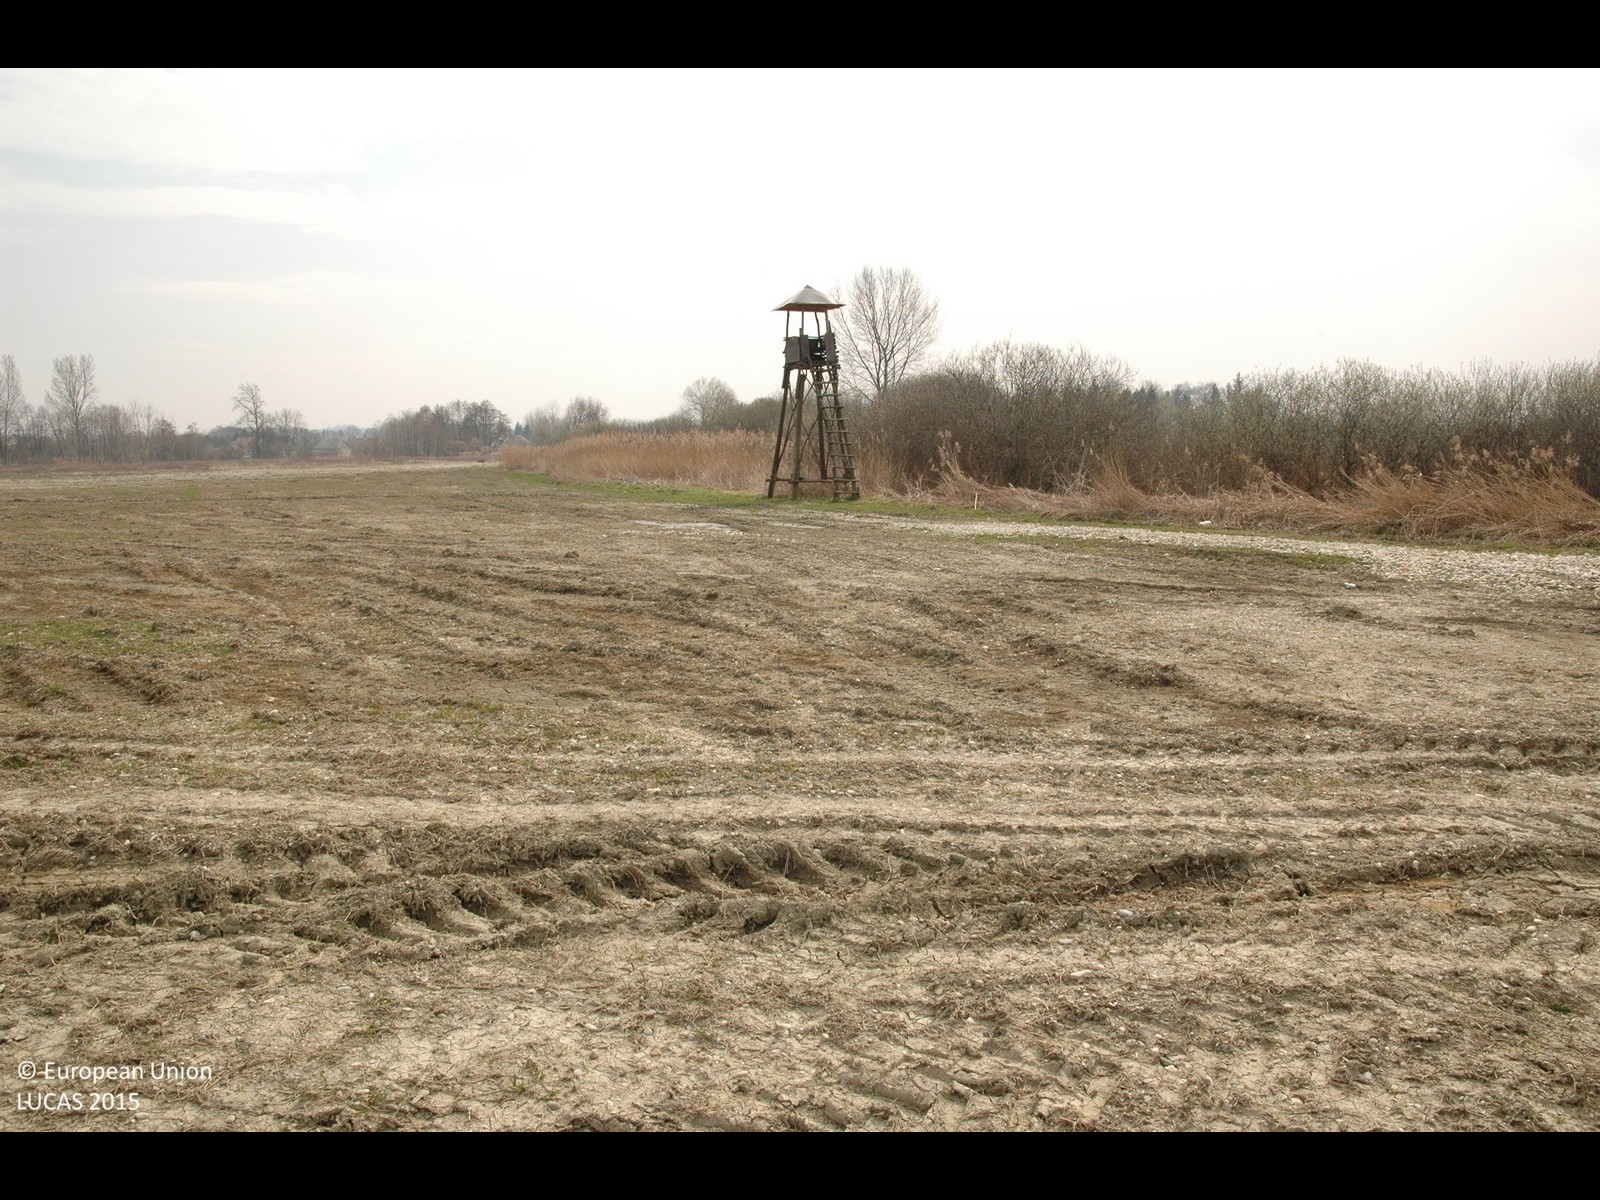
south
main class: Grassland
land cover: Spontaneously vegetated surfaces
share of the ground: > 75 %
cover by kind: herbaceous plants 100 %
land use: Agriculture (excluding fallow land and kitchen gardens)
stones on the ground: < 10 %
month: March
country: HR
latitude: 46.2860
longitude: 16.3991
